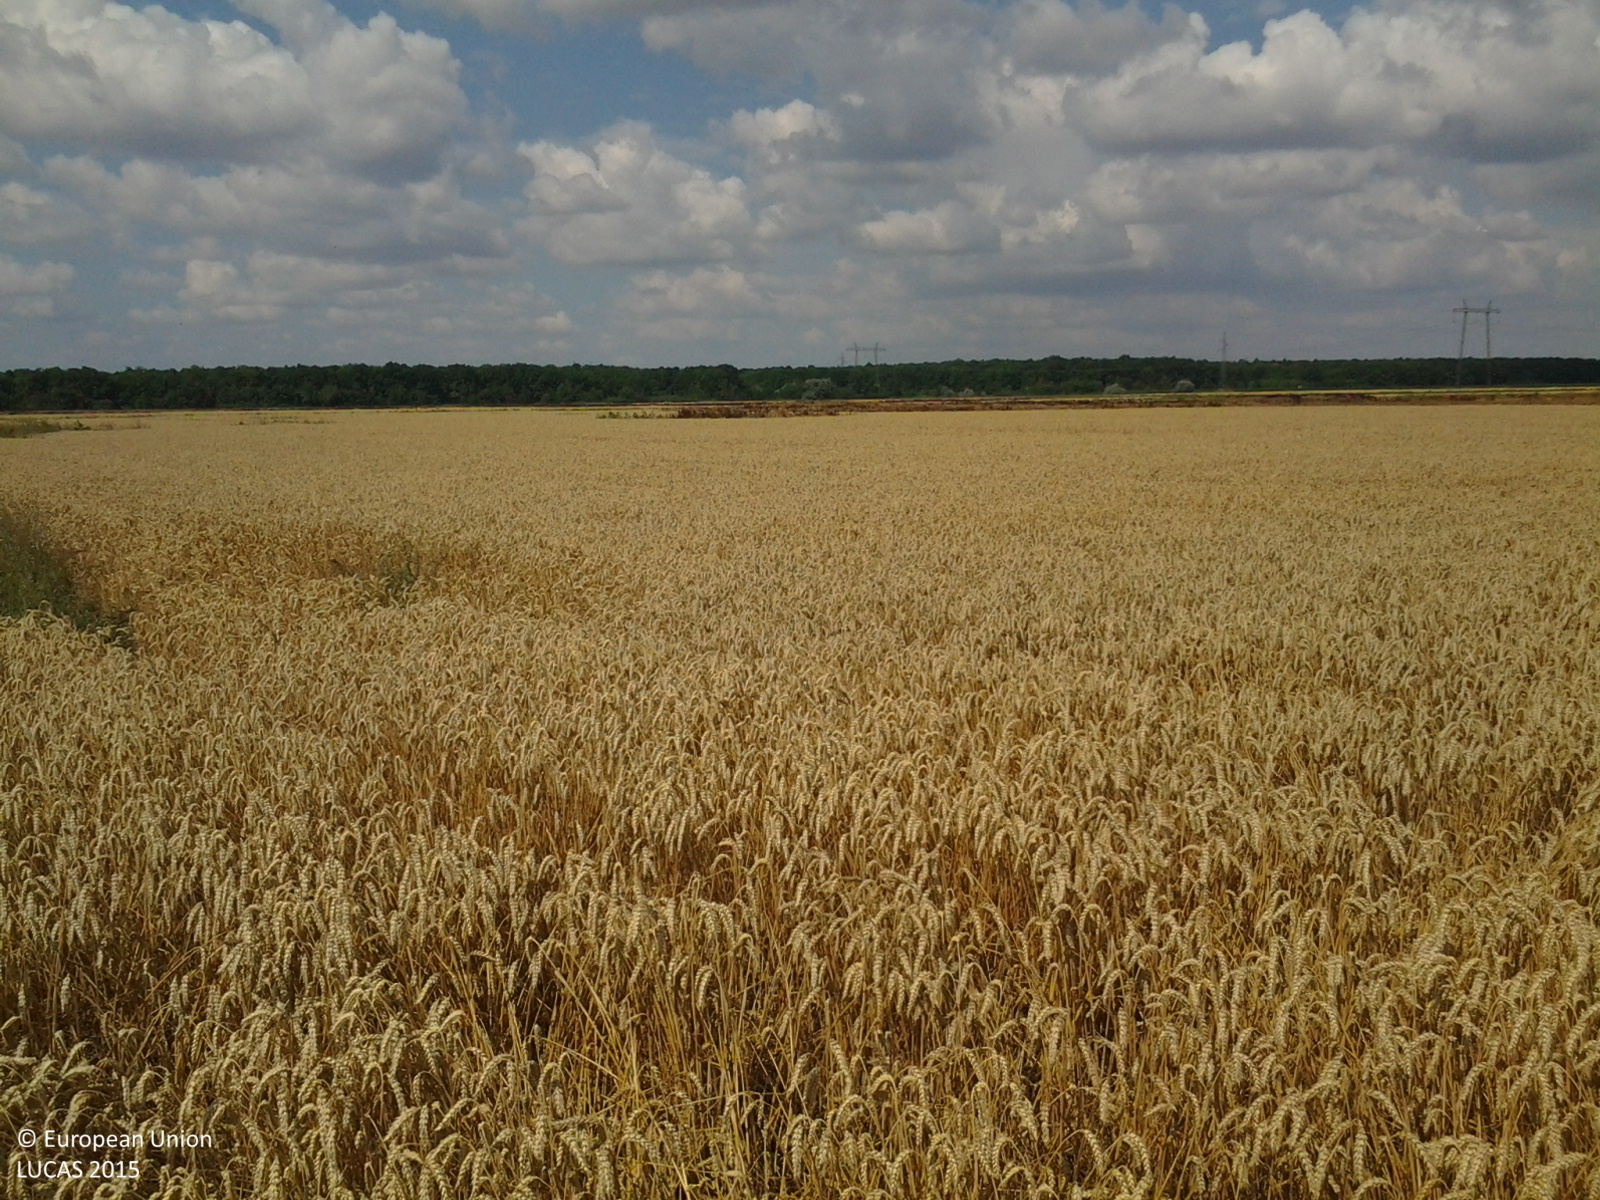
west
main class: Cropland
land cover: Common wheat
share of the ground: > 75 %
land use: Agriculture (excluding fallow land and kitchen gardens)
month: July
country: HU
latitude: 46.9251
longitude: 20.6546
